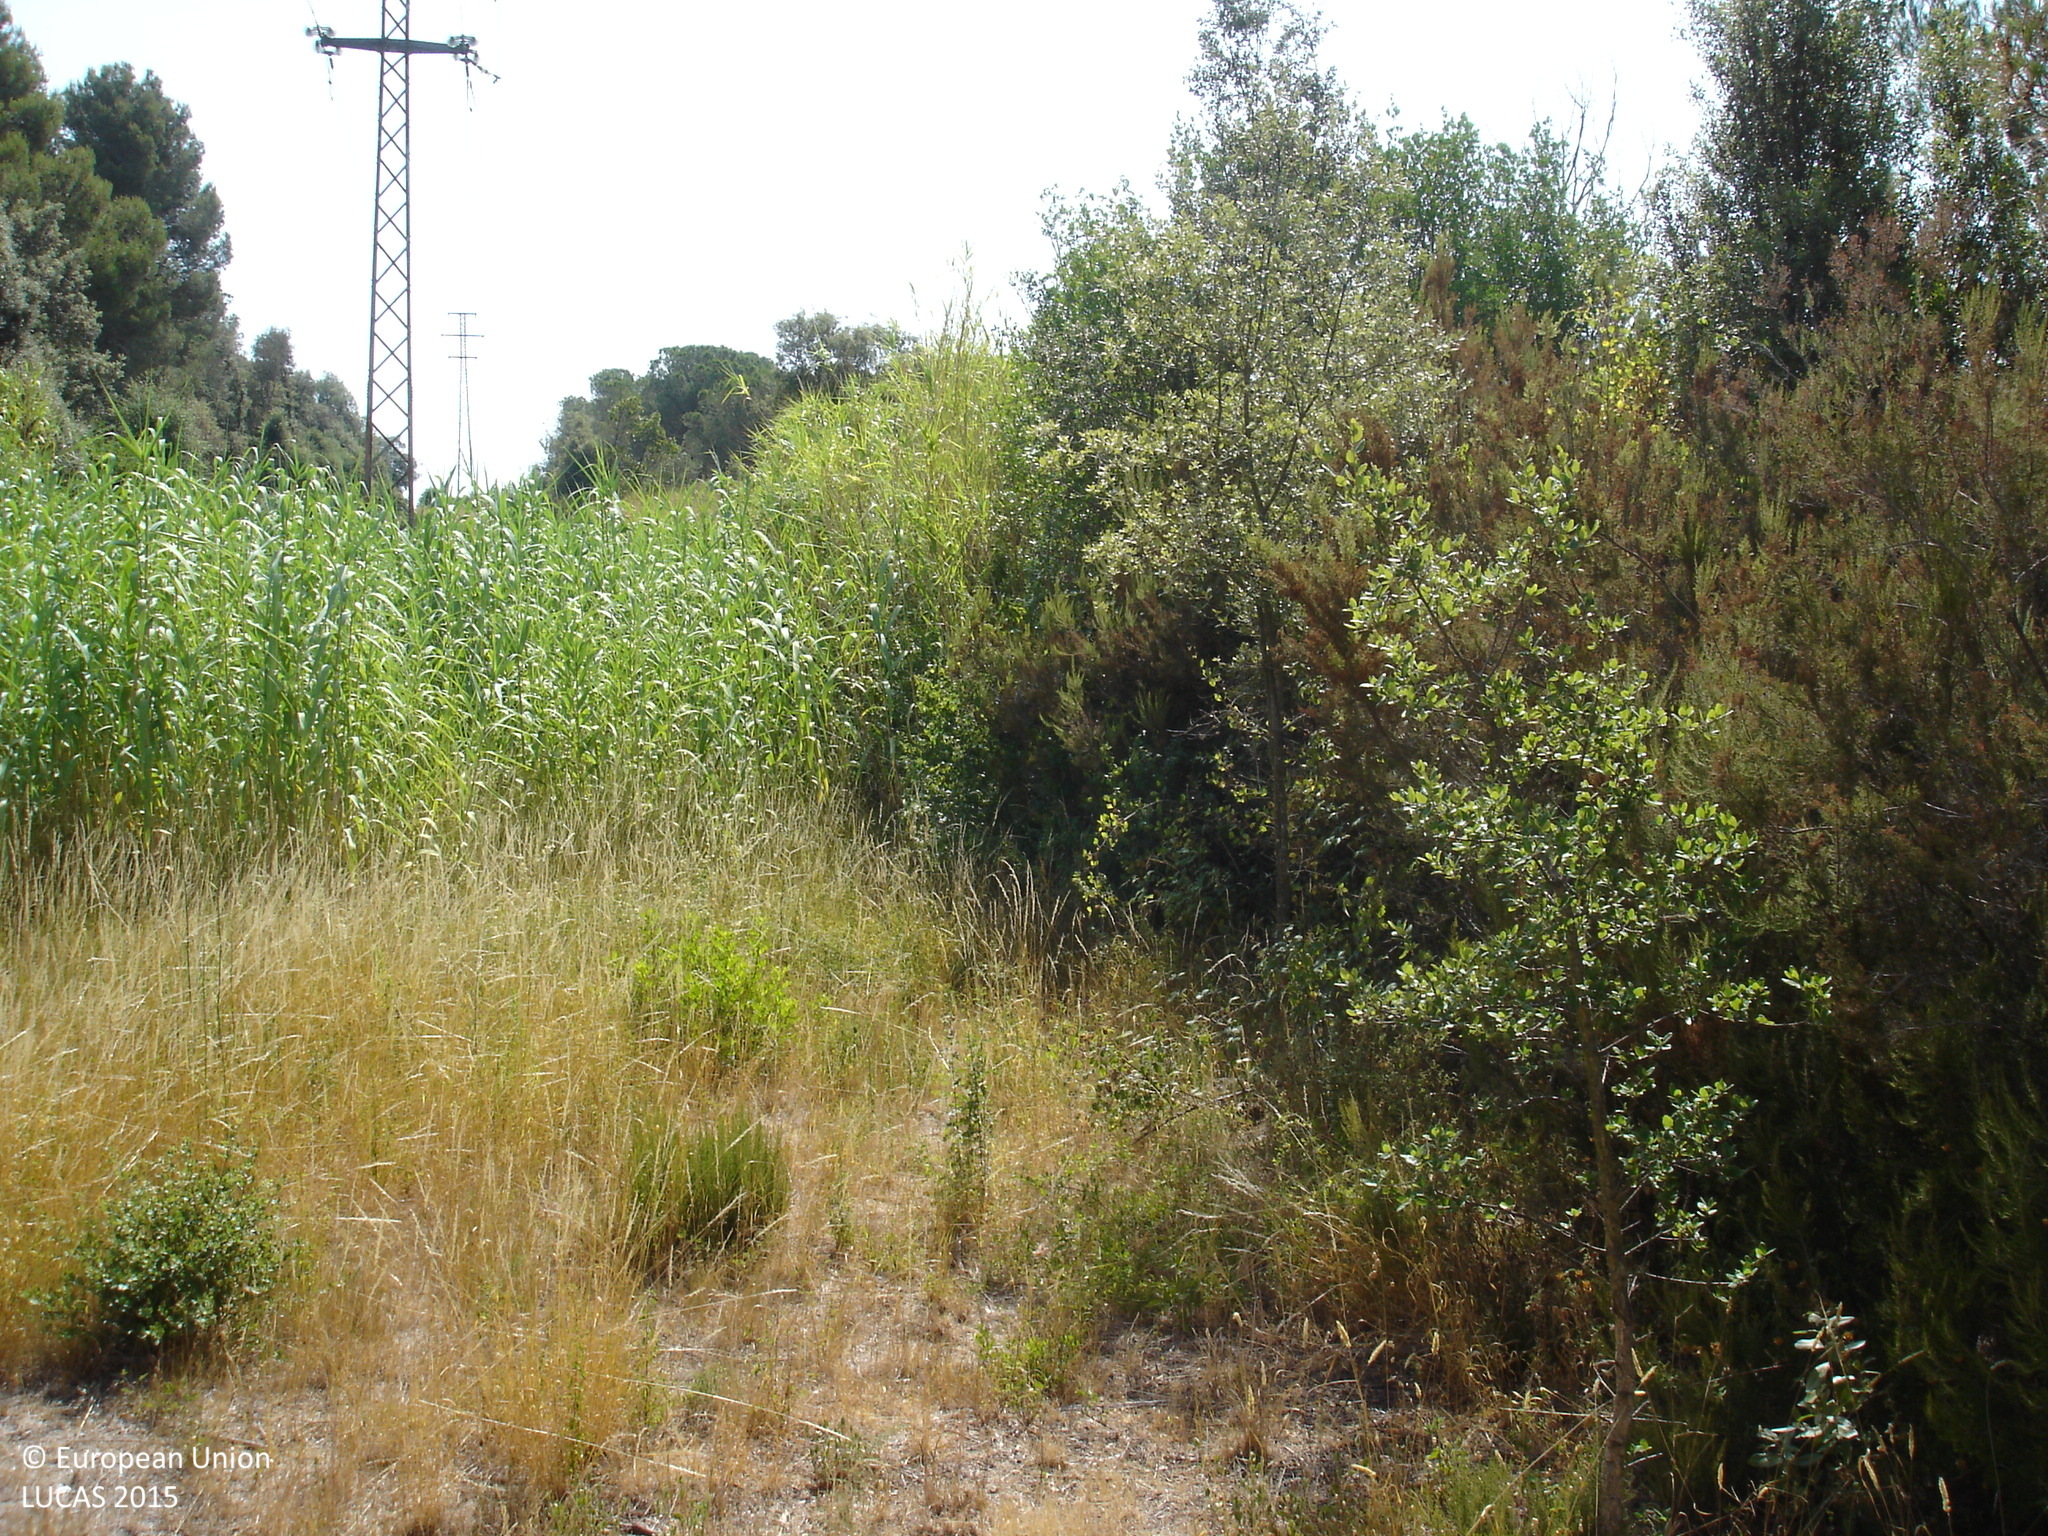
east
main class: Woodland
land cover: Other mixed woodland
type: thermophilous deciduous forest
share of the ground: 25 - 50 %
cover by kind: herbaceous plants 55 %, broadleaved forest trees 30 %, coniferous forest trees 15 %
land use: Forestry
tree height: > 5 m
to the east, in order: Other mixed woodland; Electric lines; Pine dominated mixed woodland; Other mixed woodland; Pine dominated mixed woodland; Other mixed woodland
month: July
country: ES
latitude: 41.8167
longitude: 3.0465
